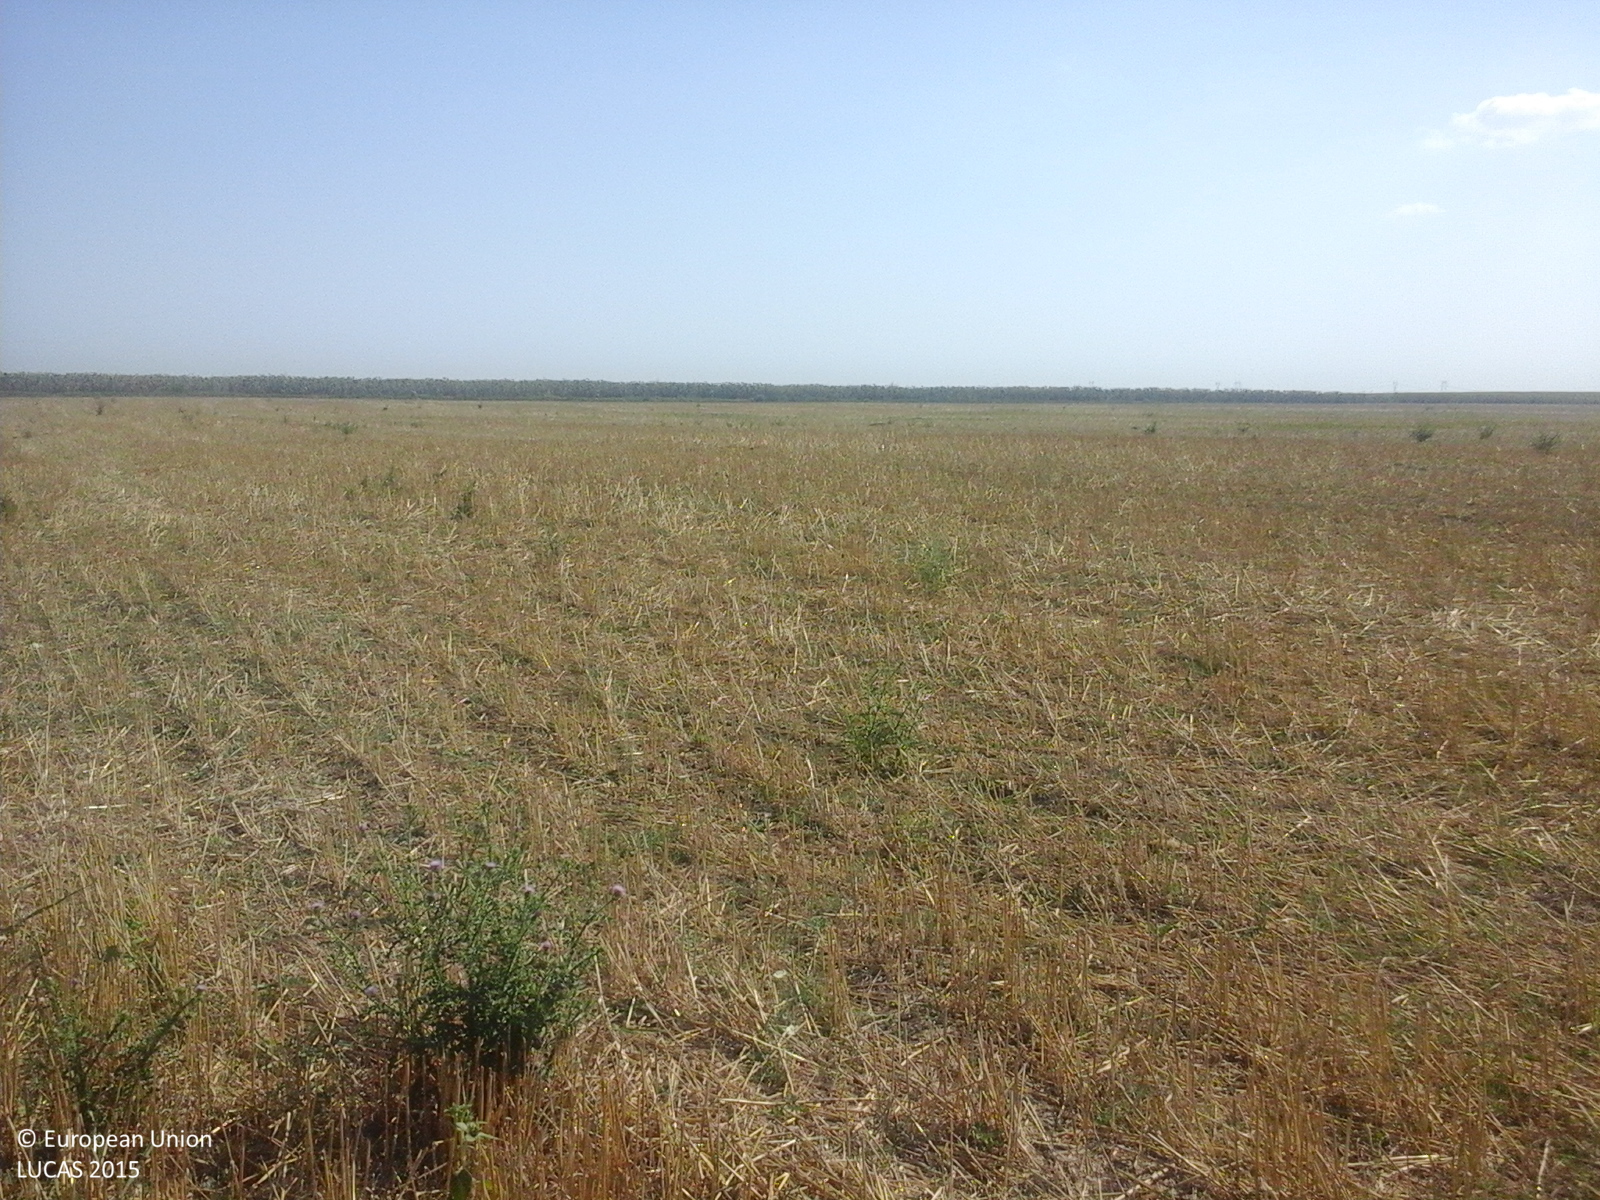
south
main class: Cropland
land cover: Barley
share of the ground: > 75 %
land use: Agriculture (excluding fallow land and kitchen gardens)
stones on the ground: < 10 %
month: August
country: RO
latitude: 44.5636
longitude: 28.1295
